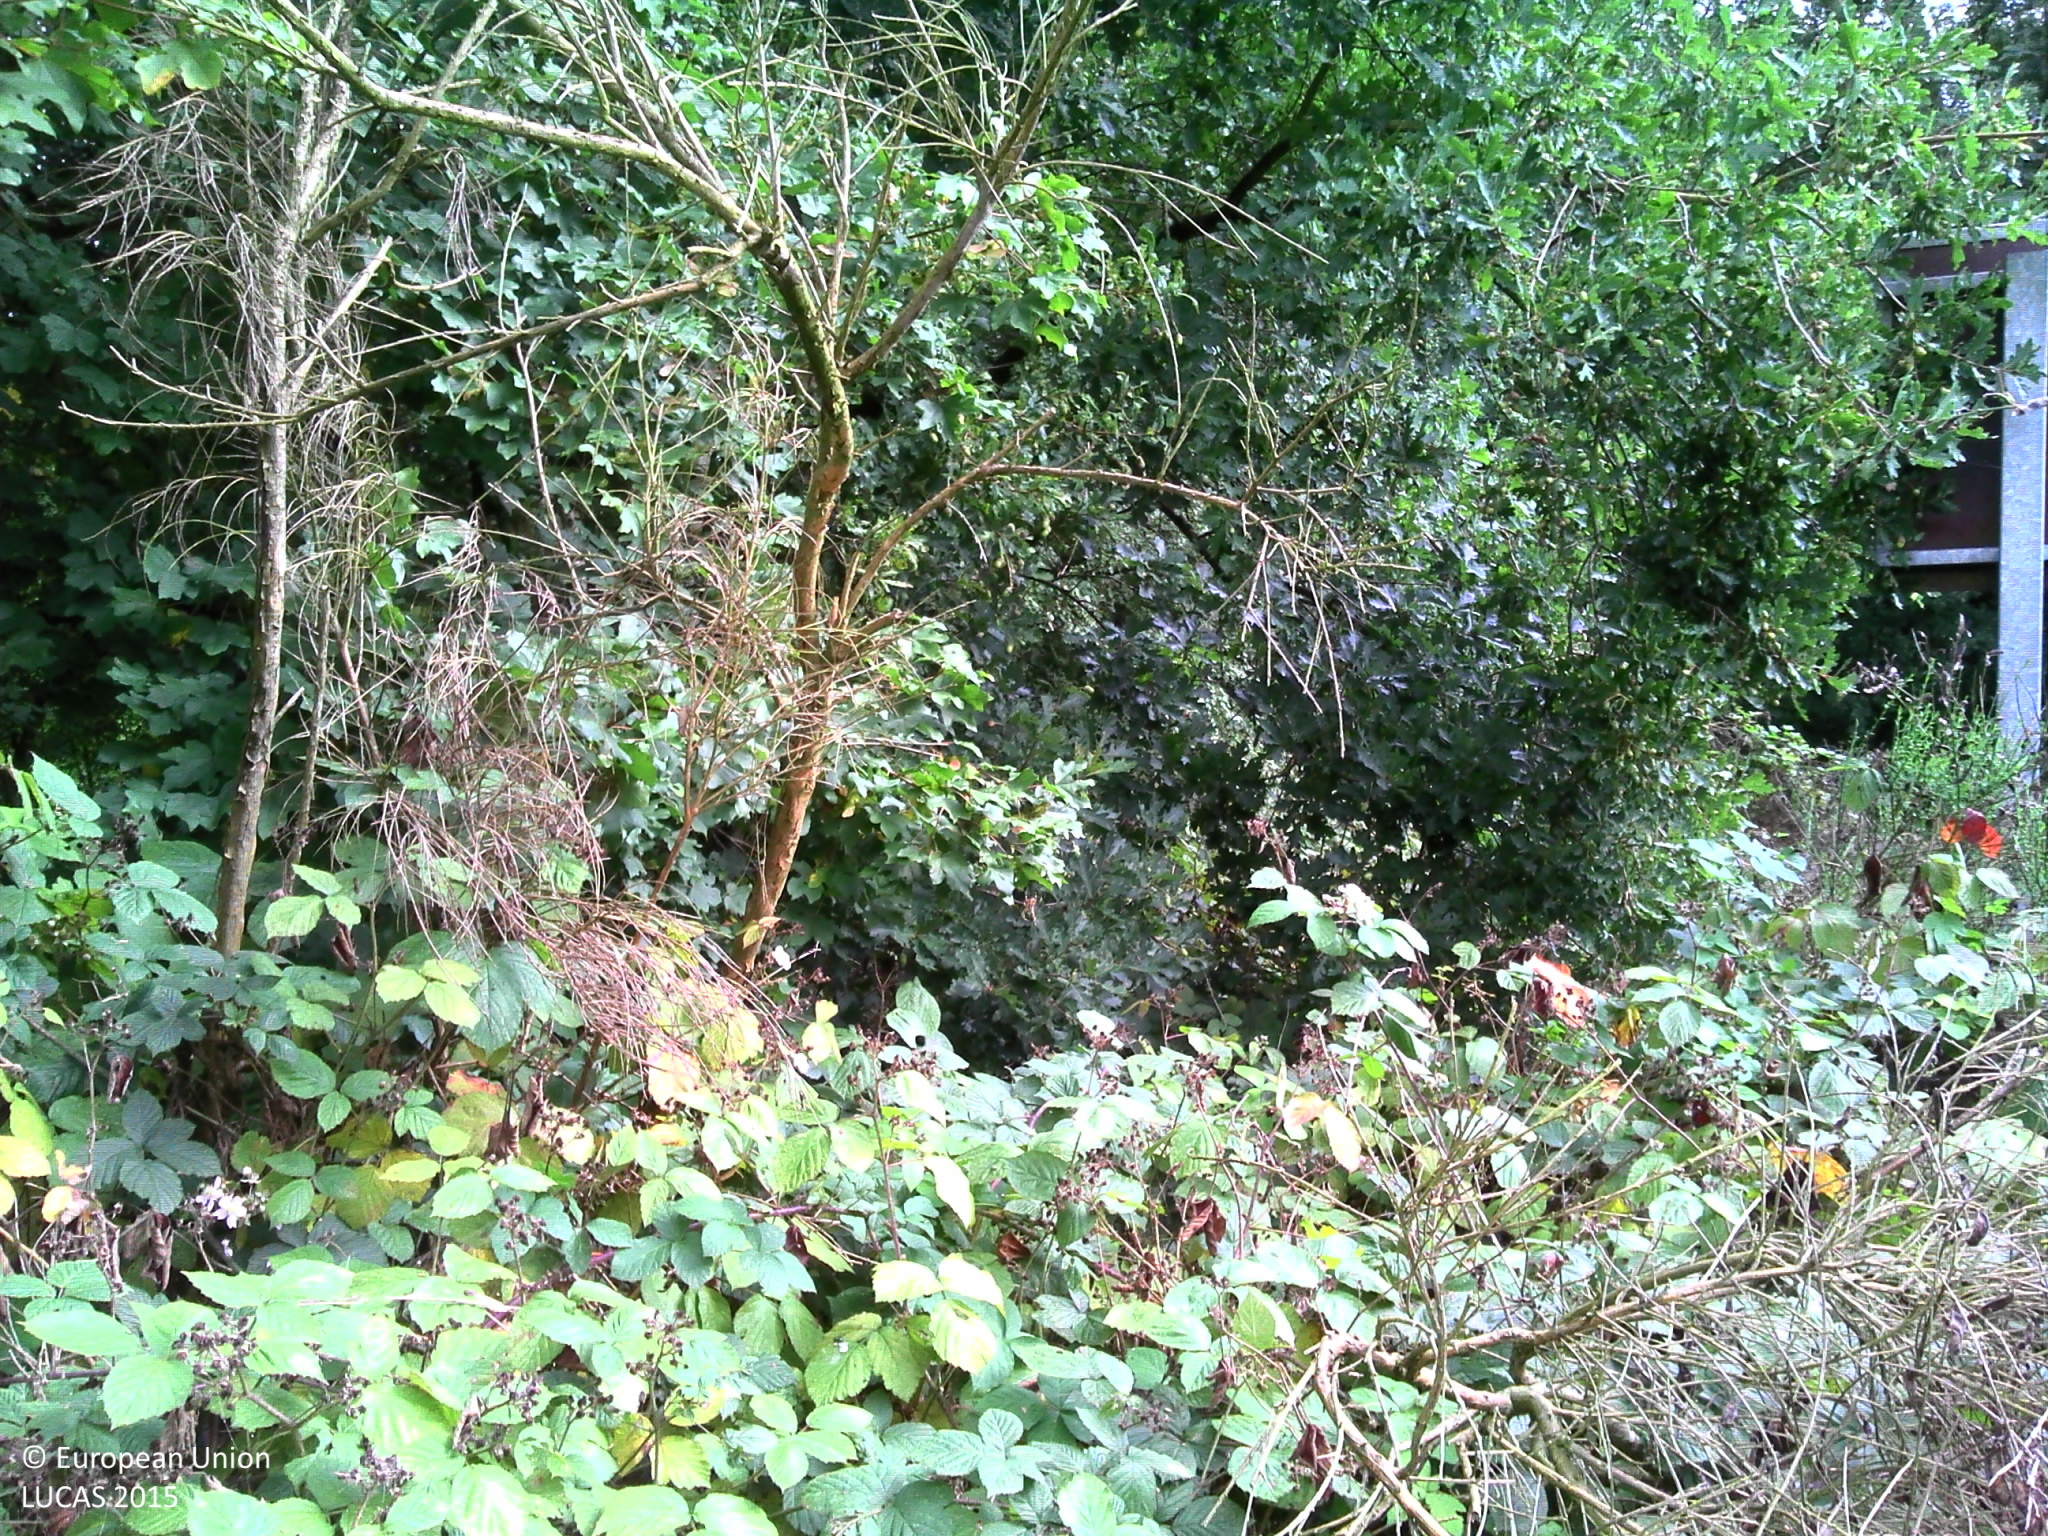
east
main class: Woodland
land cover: Broadleaved woodland
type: mesophytic deciduous forest
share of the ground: > 75 %
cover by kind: broadleaved forest trees 90 %, shrubs 5 %, herbaceous plants 5 %
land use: Amenities, museums, leisure
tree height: > 5 m
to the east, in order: Broadleaved woodland; Tracks; Broadleaved woodland; Inland fresh water bodies; Broadleaved woodland; Tracks; Broadleaved woodland; Tracks; Broadleaved woodland; Tracks; Broadleaved woodland
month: September
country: BE
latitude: 51.1657
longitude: 4.4325
